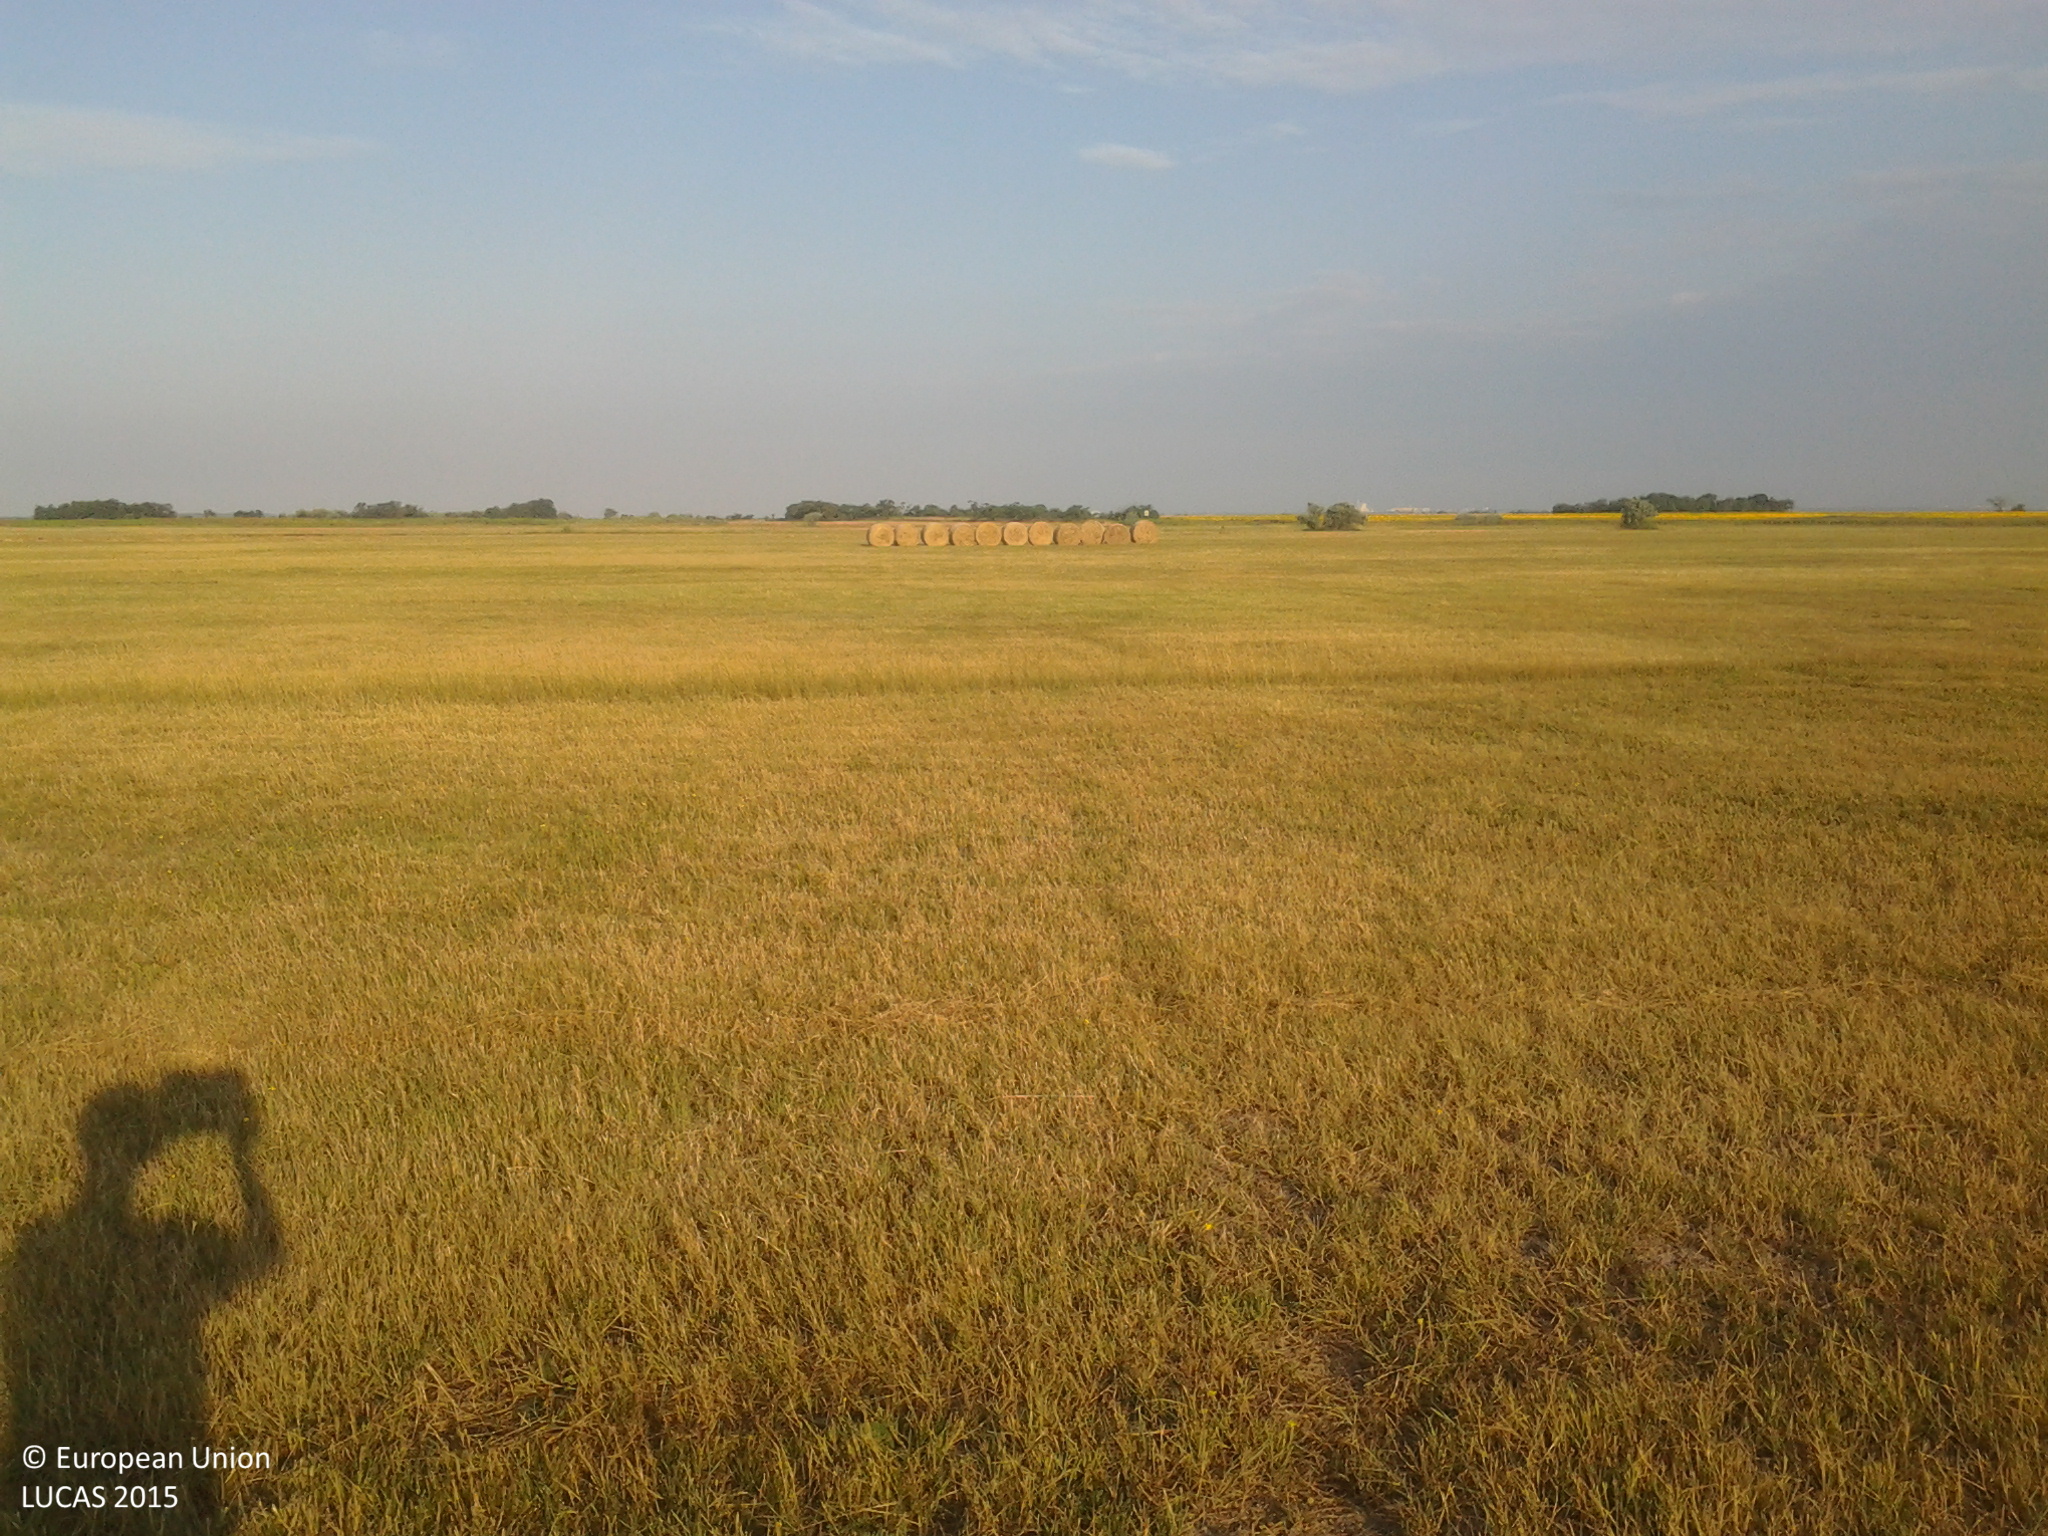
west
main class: Grassland
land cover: Grassland without tree/shrub cover
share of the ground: 50 - 75 %
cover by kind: herbaceous plants 100 %
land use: Agriculture (excluding fallow land and kitchen gardens)
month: July
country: HU
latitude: 46.8858
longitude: 19.1104
